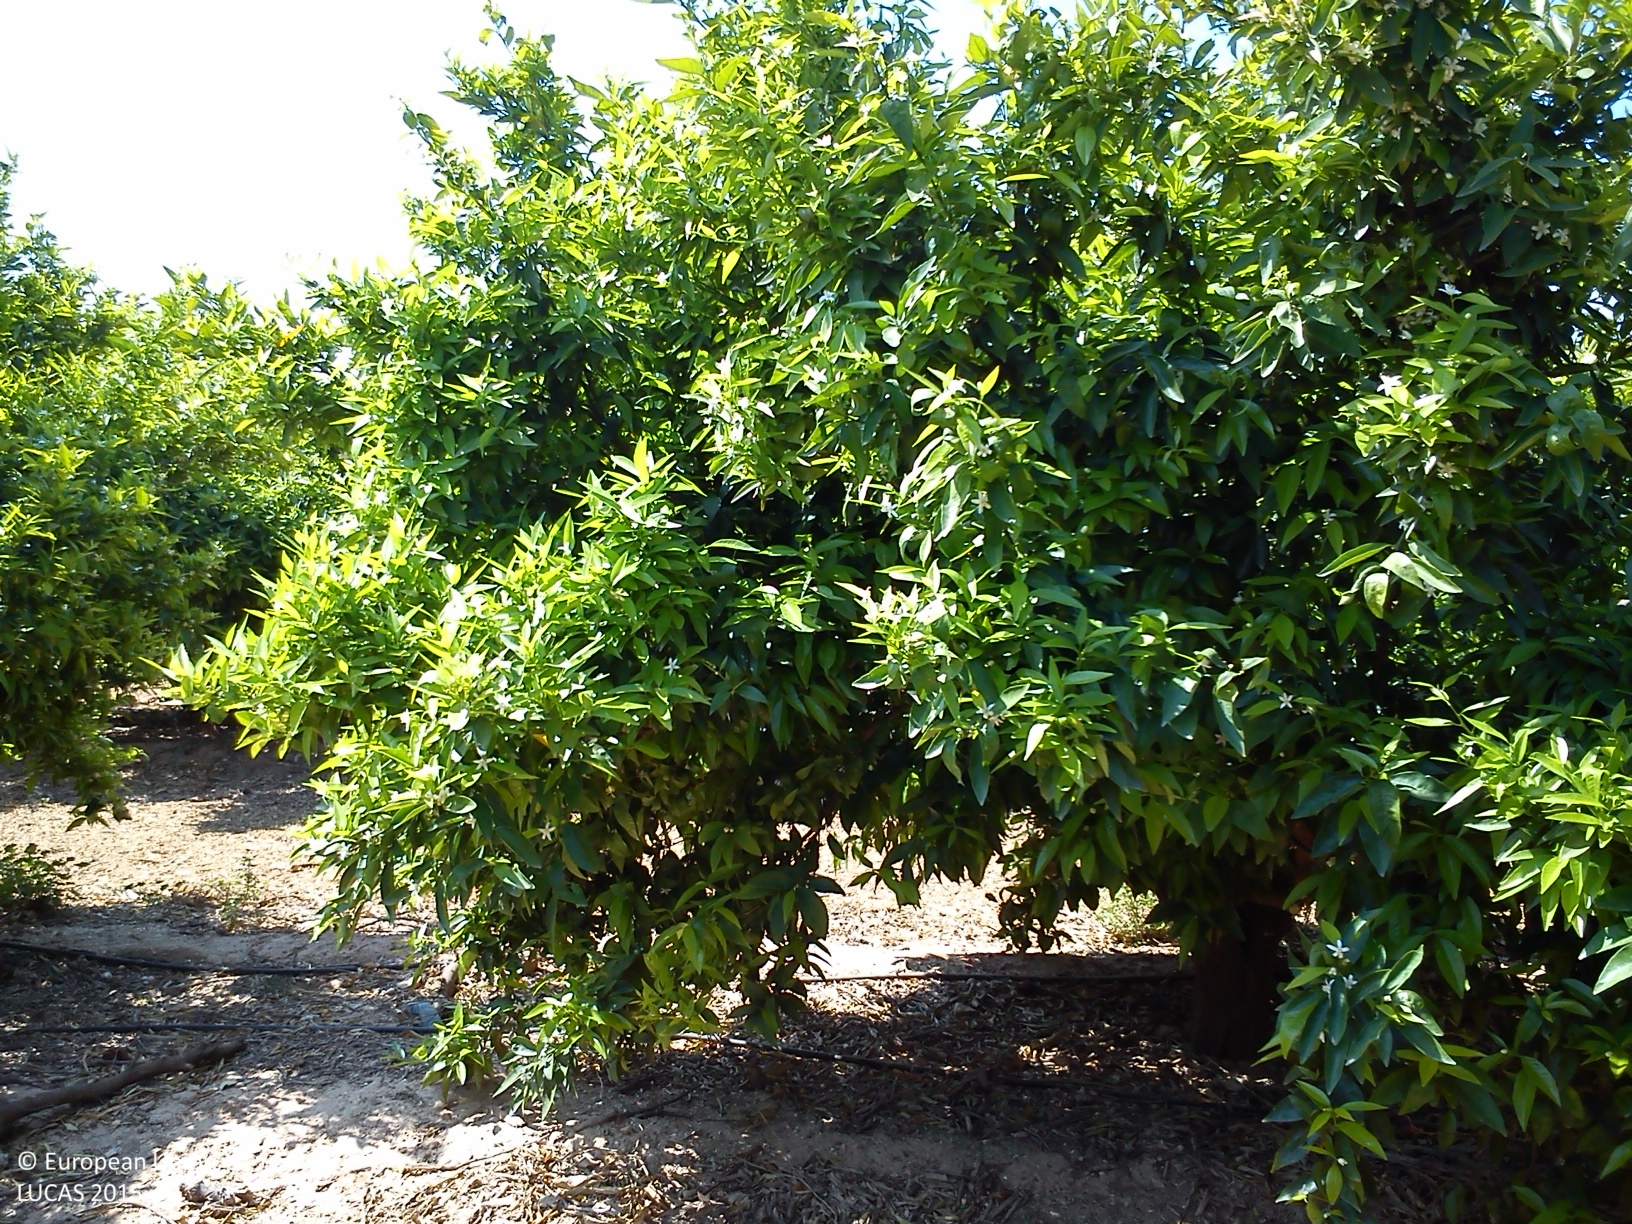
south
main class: Cropland
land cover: Oranges
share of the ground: 50 - 75 %
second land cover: Other bare soil
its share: > 75 %
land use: Agriculture (excluding fallow land and kitchen gardens)
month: April
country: ES
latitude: 39.6096
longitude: -0.6808
